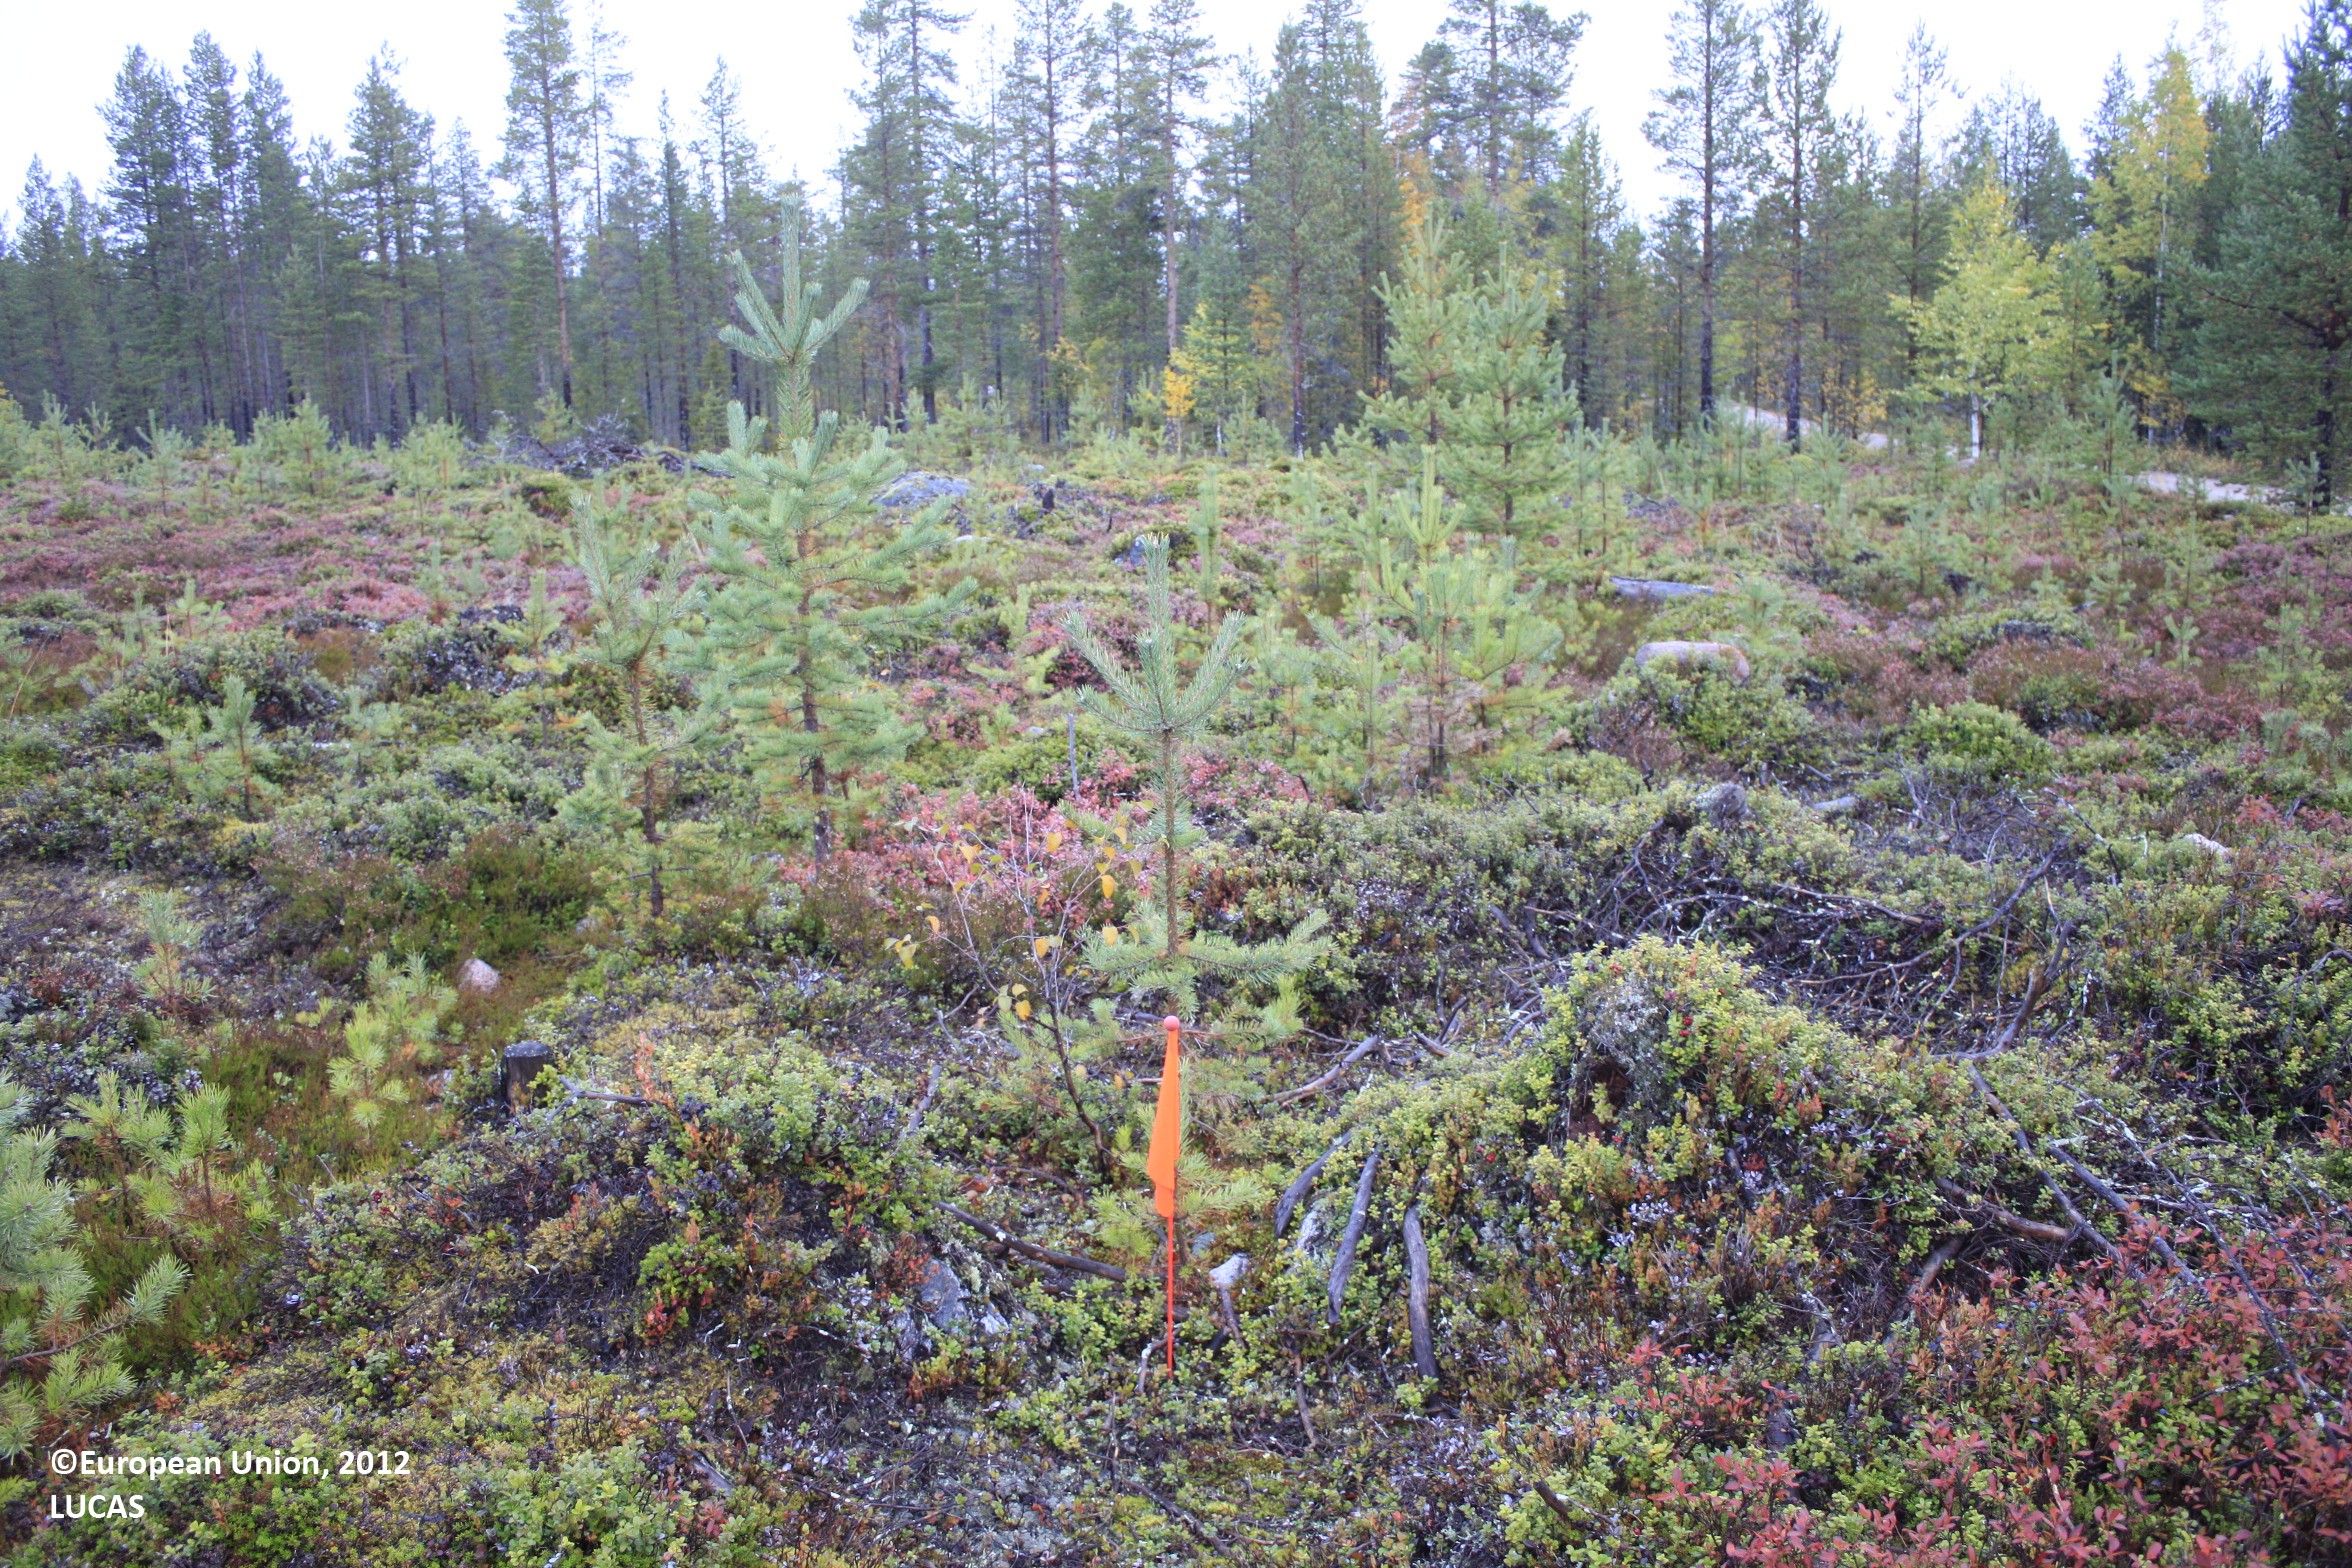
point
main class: Woodland
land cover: Pine dominated coniferous woodland
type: boreal forest
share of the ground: 10 - 25 %
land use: Forestry
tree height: < 5 m
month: September
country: FI
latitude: 66.0205
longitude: 26.7943
